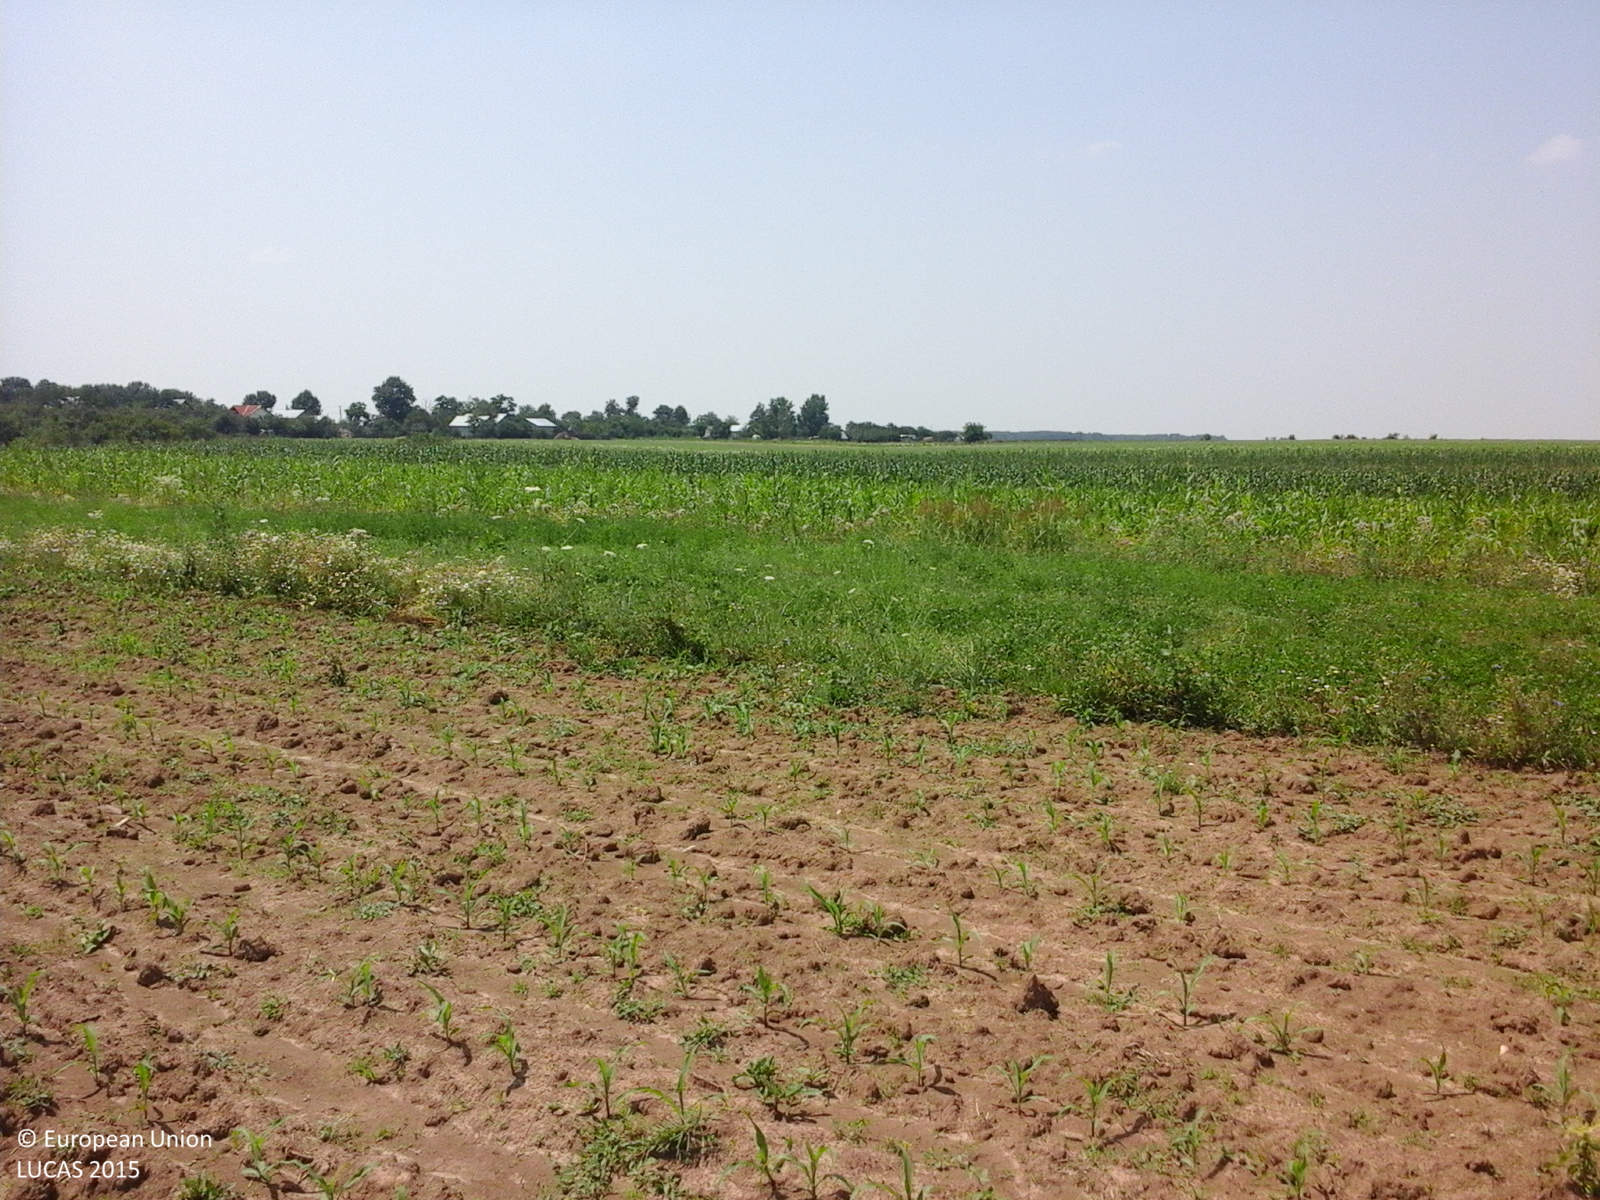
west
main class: Cropland
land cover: Maize
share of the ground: < 10 %
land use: Agriculture (excluding fallow land and kitchen gardens)
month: July
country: RO
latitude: 44.5518
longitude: 25.3843
